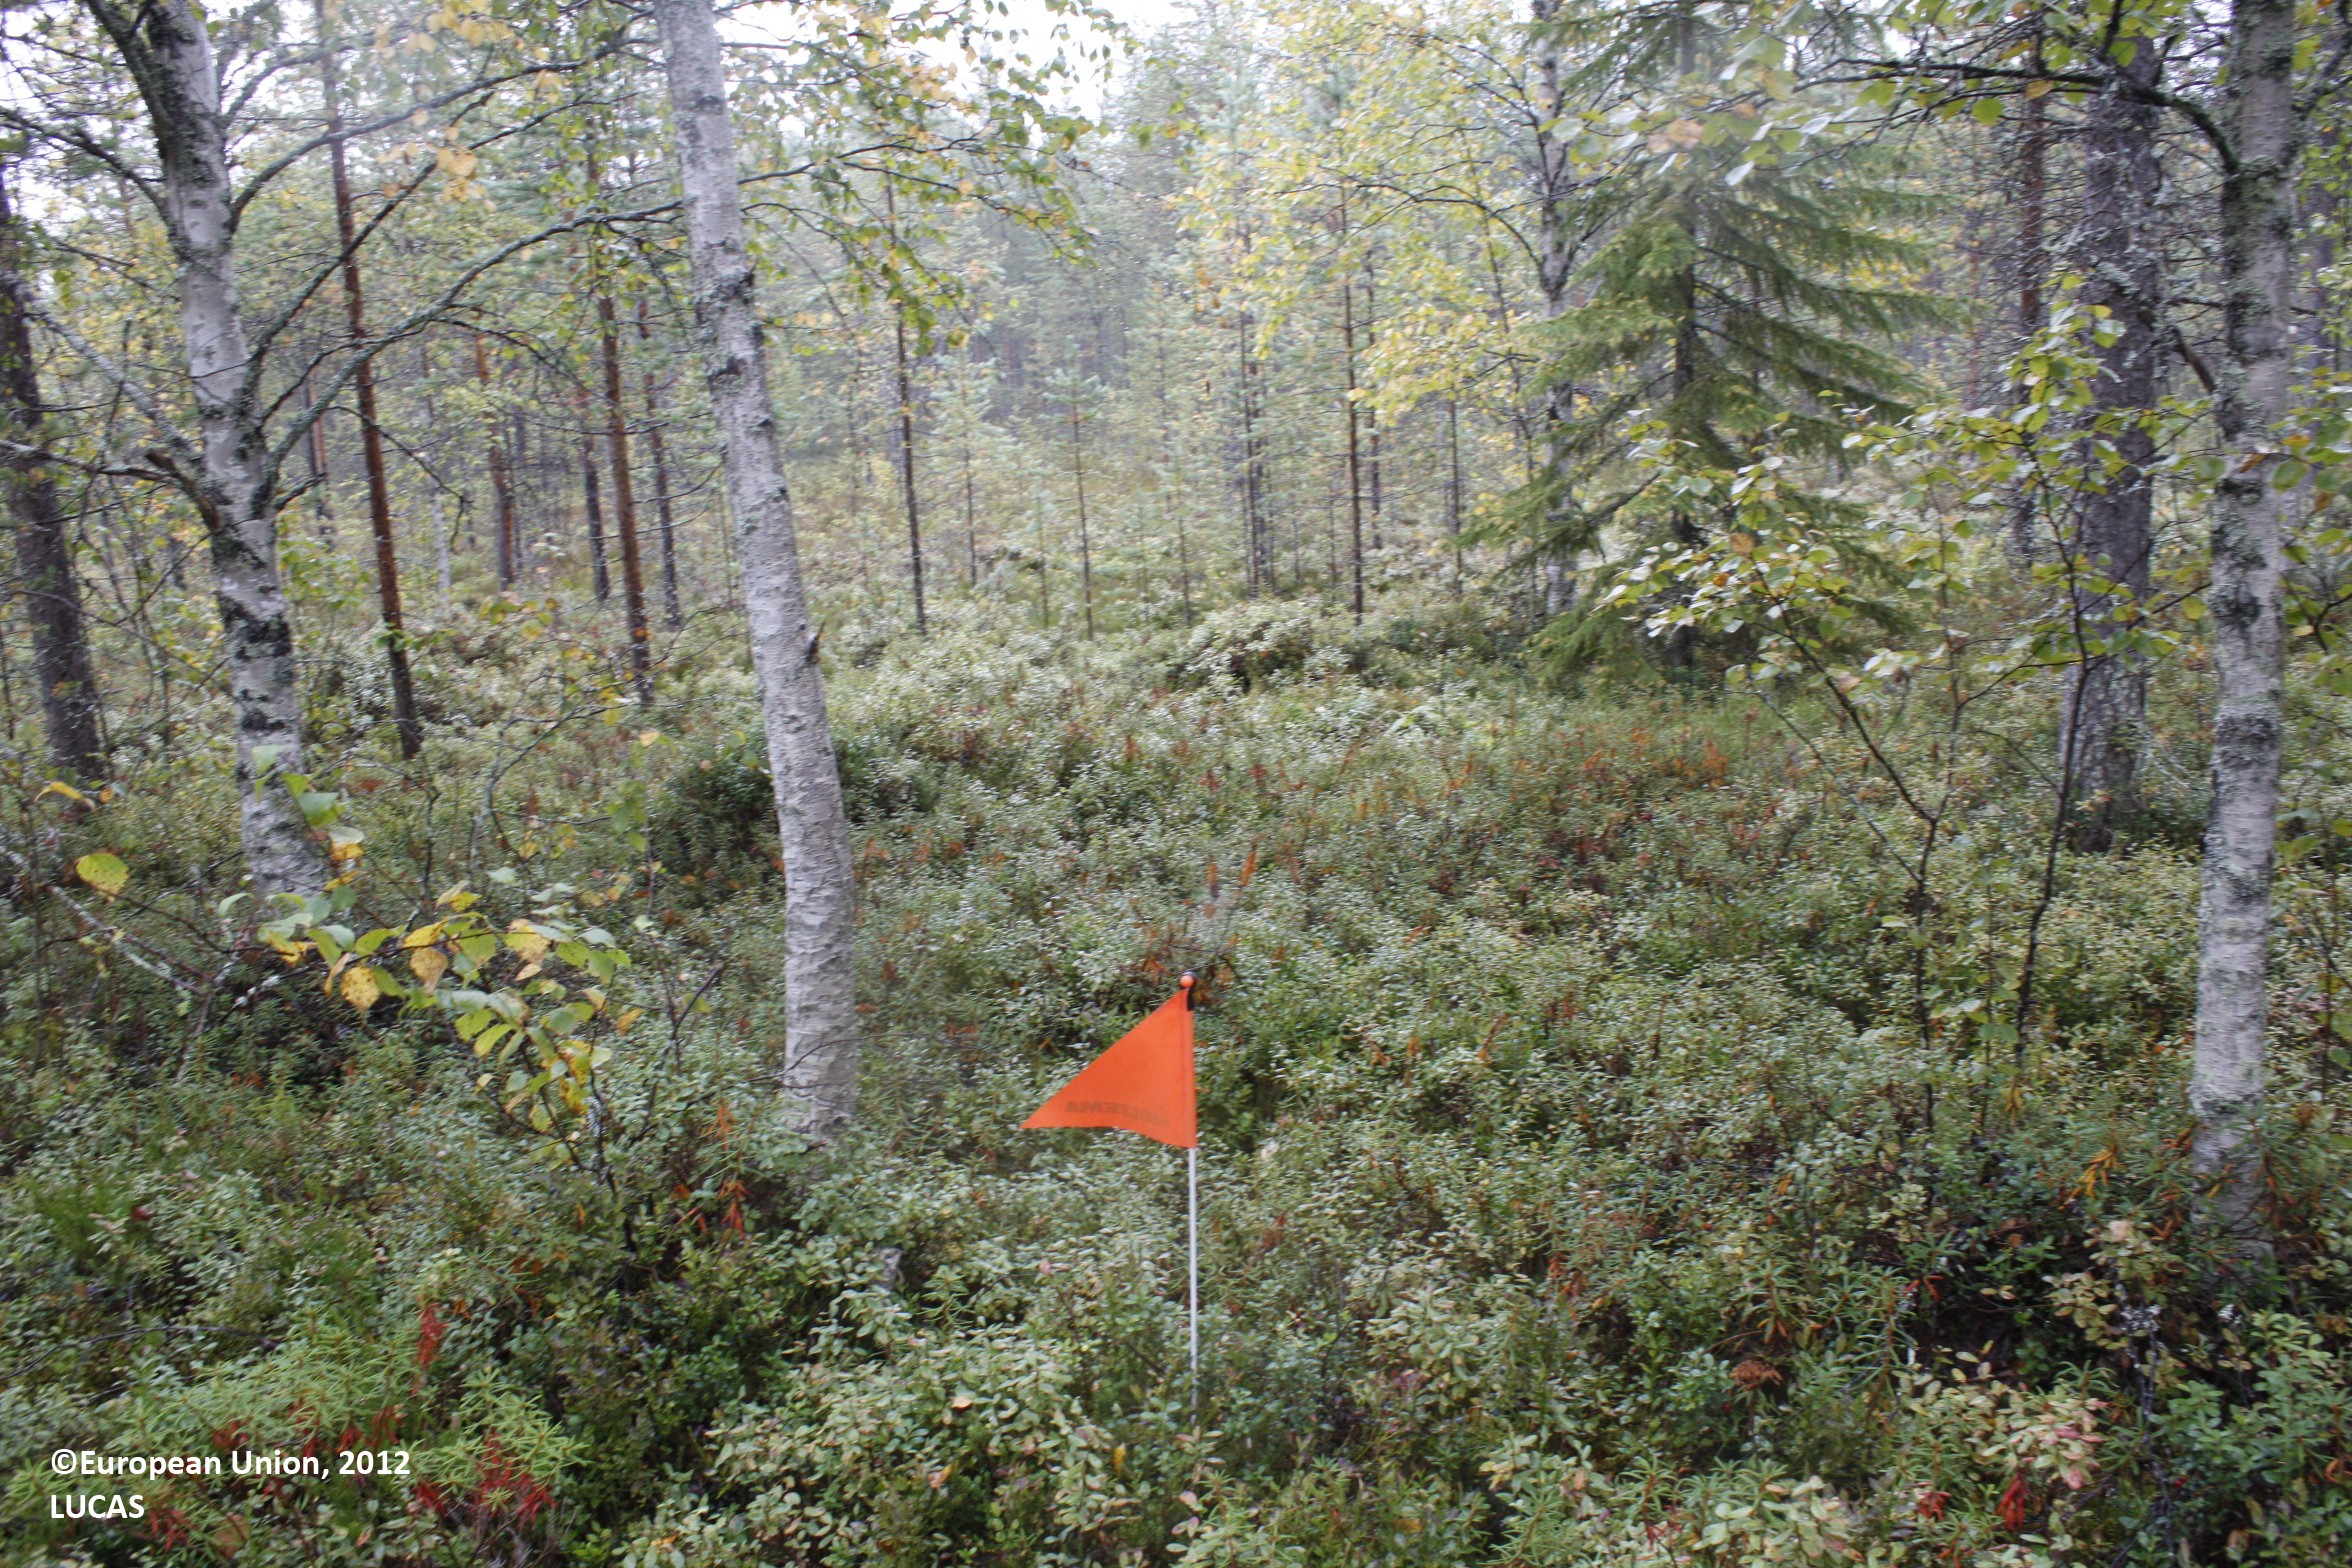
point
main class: Woodland
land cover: Pine dominated mixed woodland
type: mire and swamp forests
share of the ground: 25 - 50 %
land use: Forestry
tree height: > 5 m
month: September
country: FI
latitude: 65.3362
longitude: 26.9315
